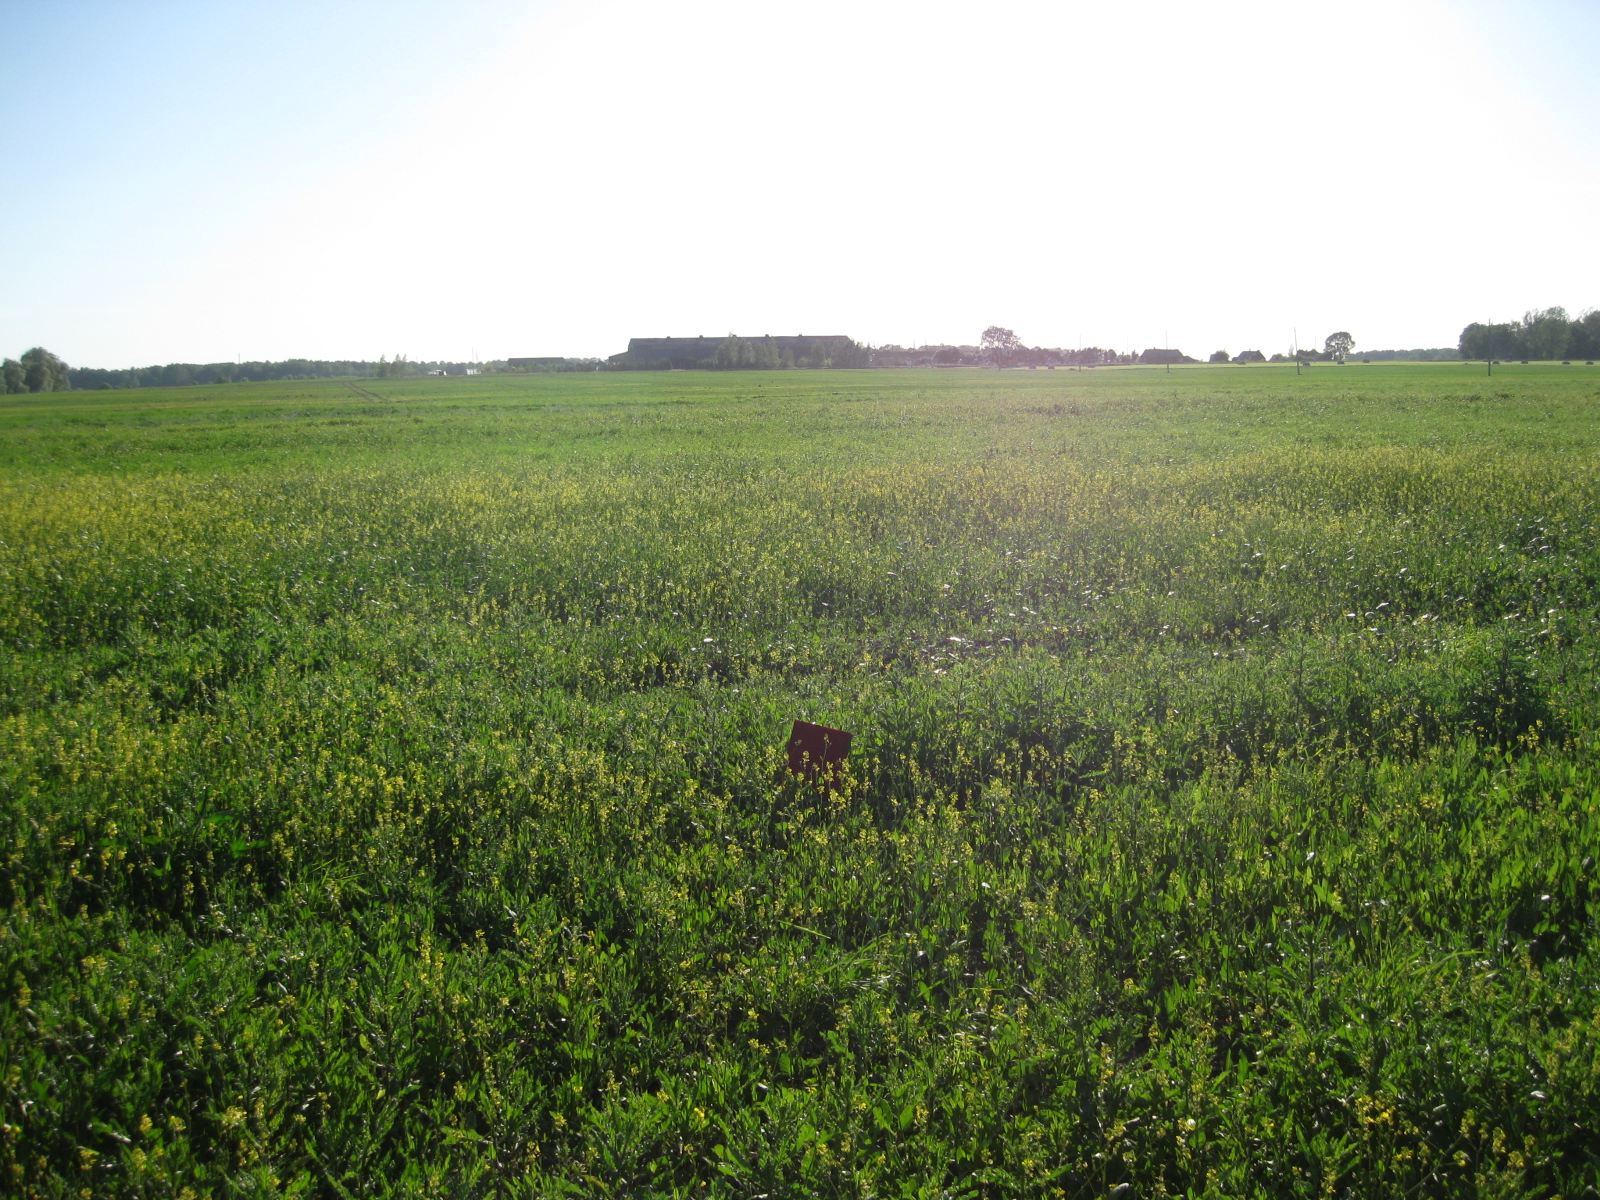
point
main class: Cropland
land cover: Rape and turnip rape
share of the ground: > 75 %
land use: Agriculture (excluding fallow land and kitchen gardens)
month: June
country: LT
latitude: 55.8043
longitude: 23.9511
